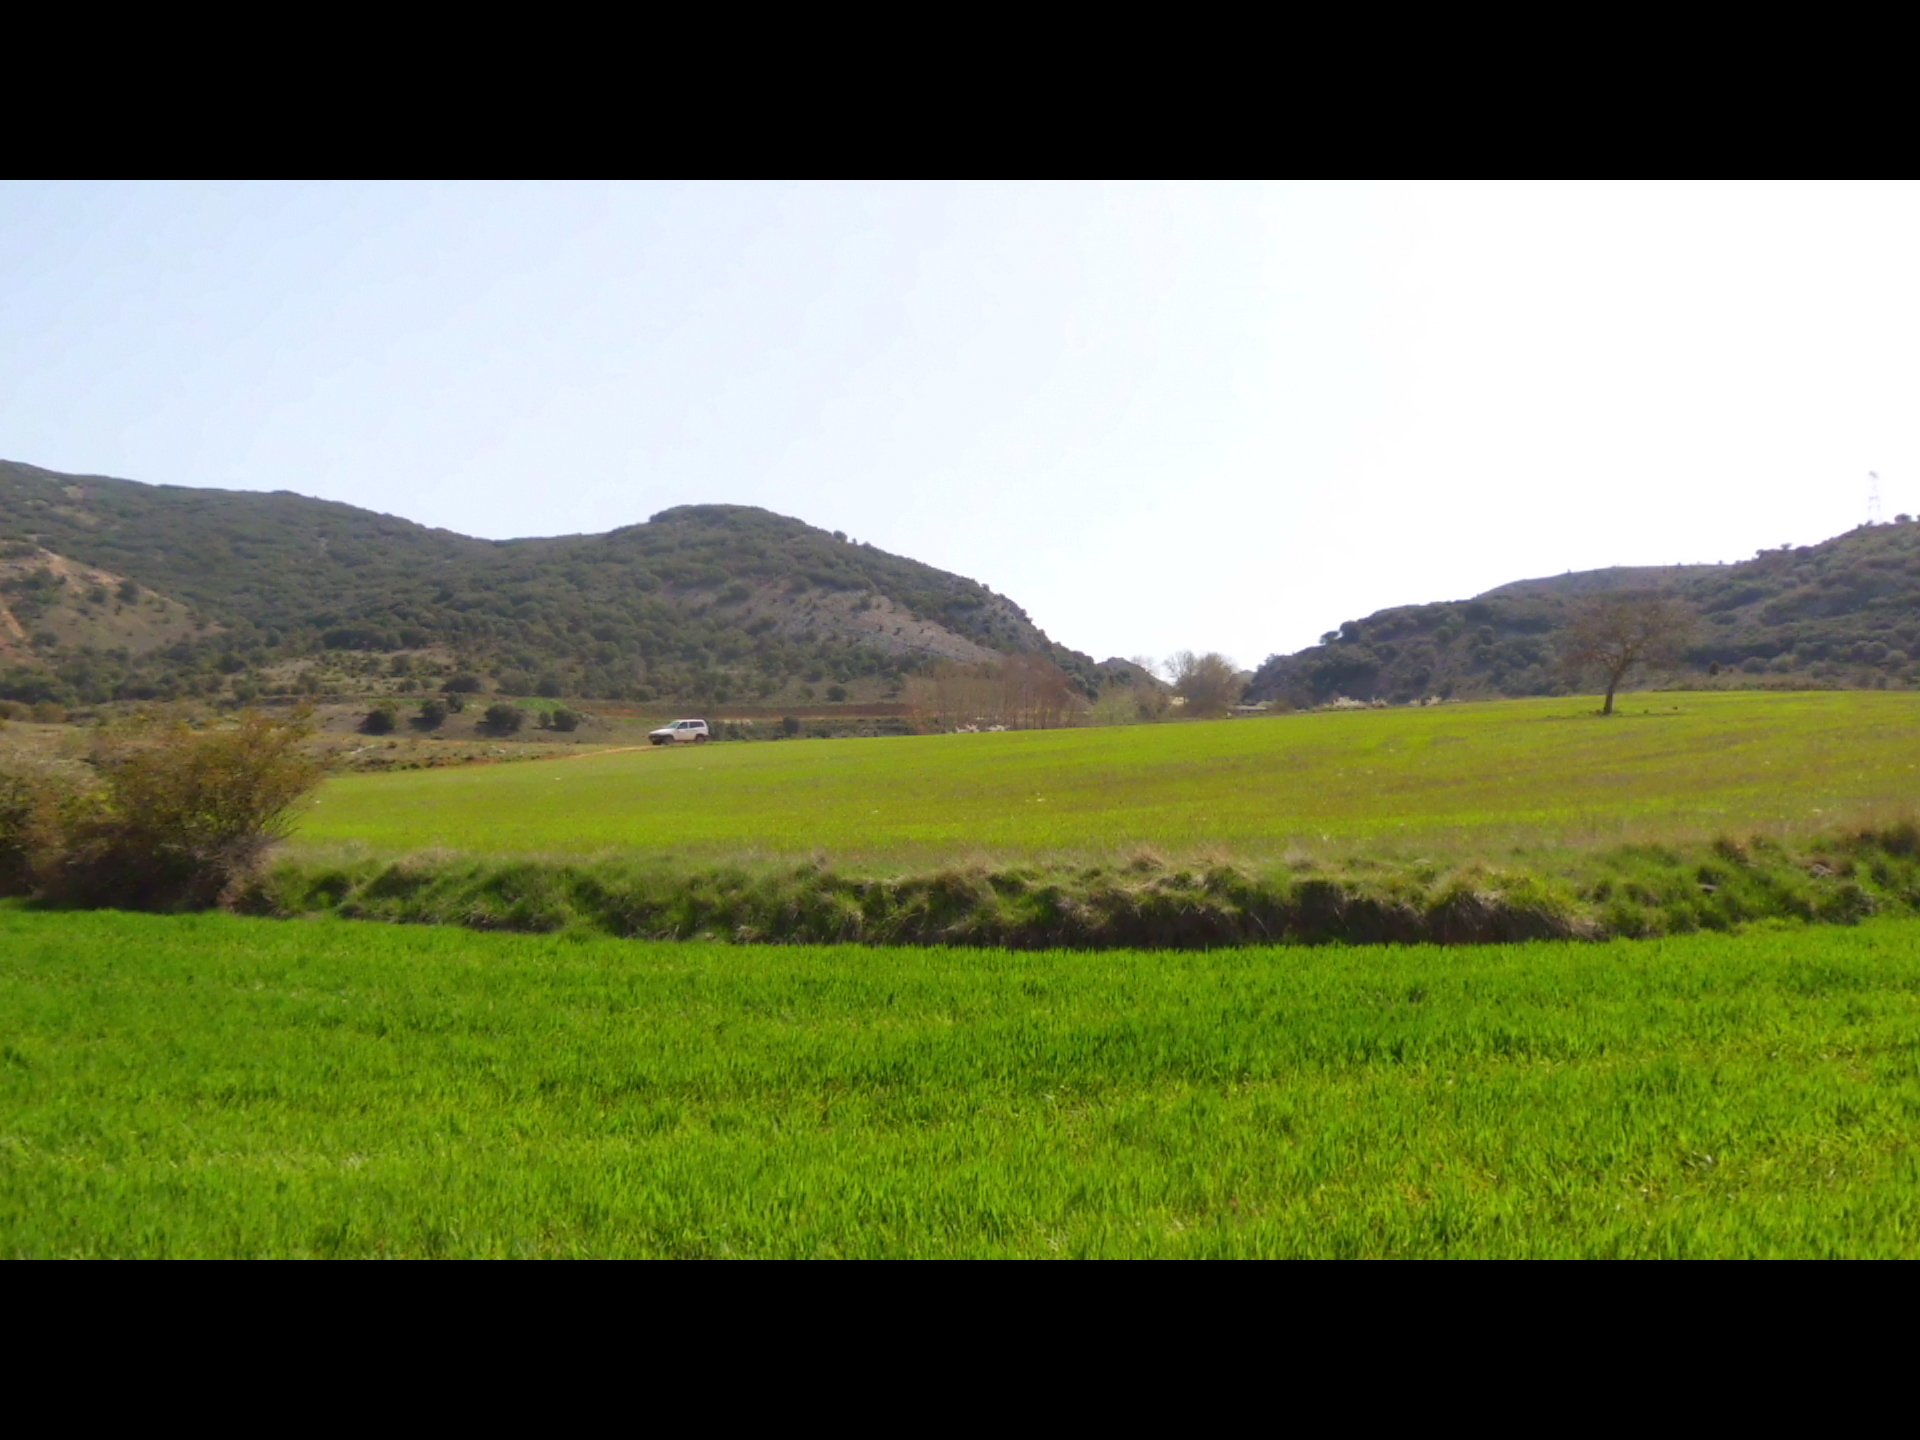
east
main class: Cropland
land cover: Common wheat
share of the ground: > 75 %
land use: Agriculture (excluding fallow land and kitchen gardens)
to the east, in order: Shruby margins; Common wheat; Grass margins; Barley; Tracks; Other bare soil
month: April
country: ES
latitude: 42.5607
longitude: -3.4205
